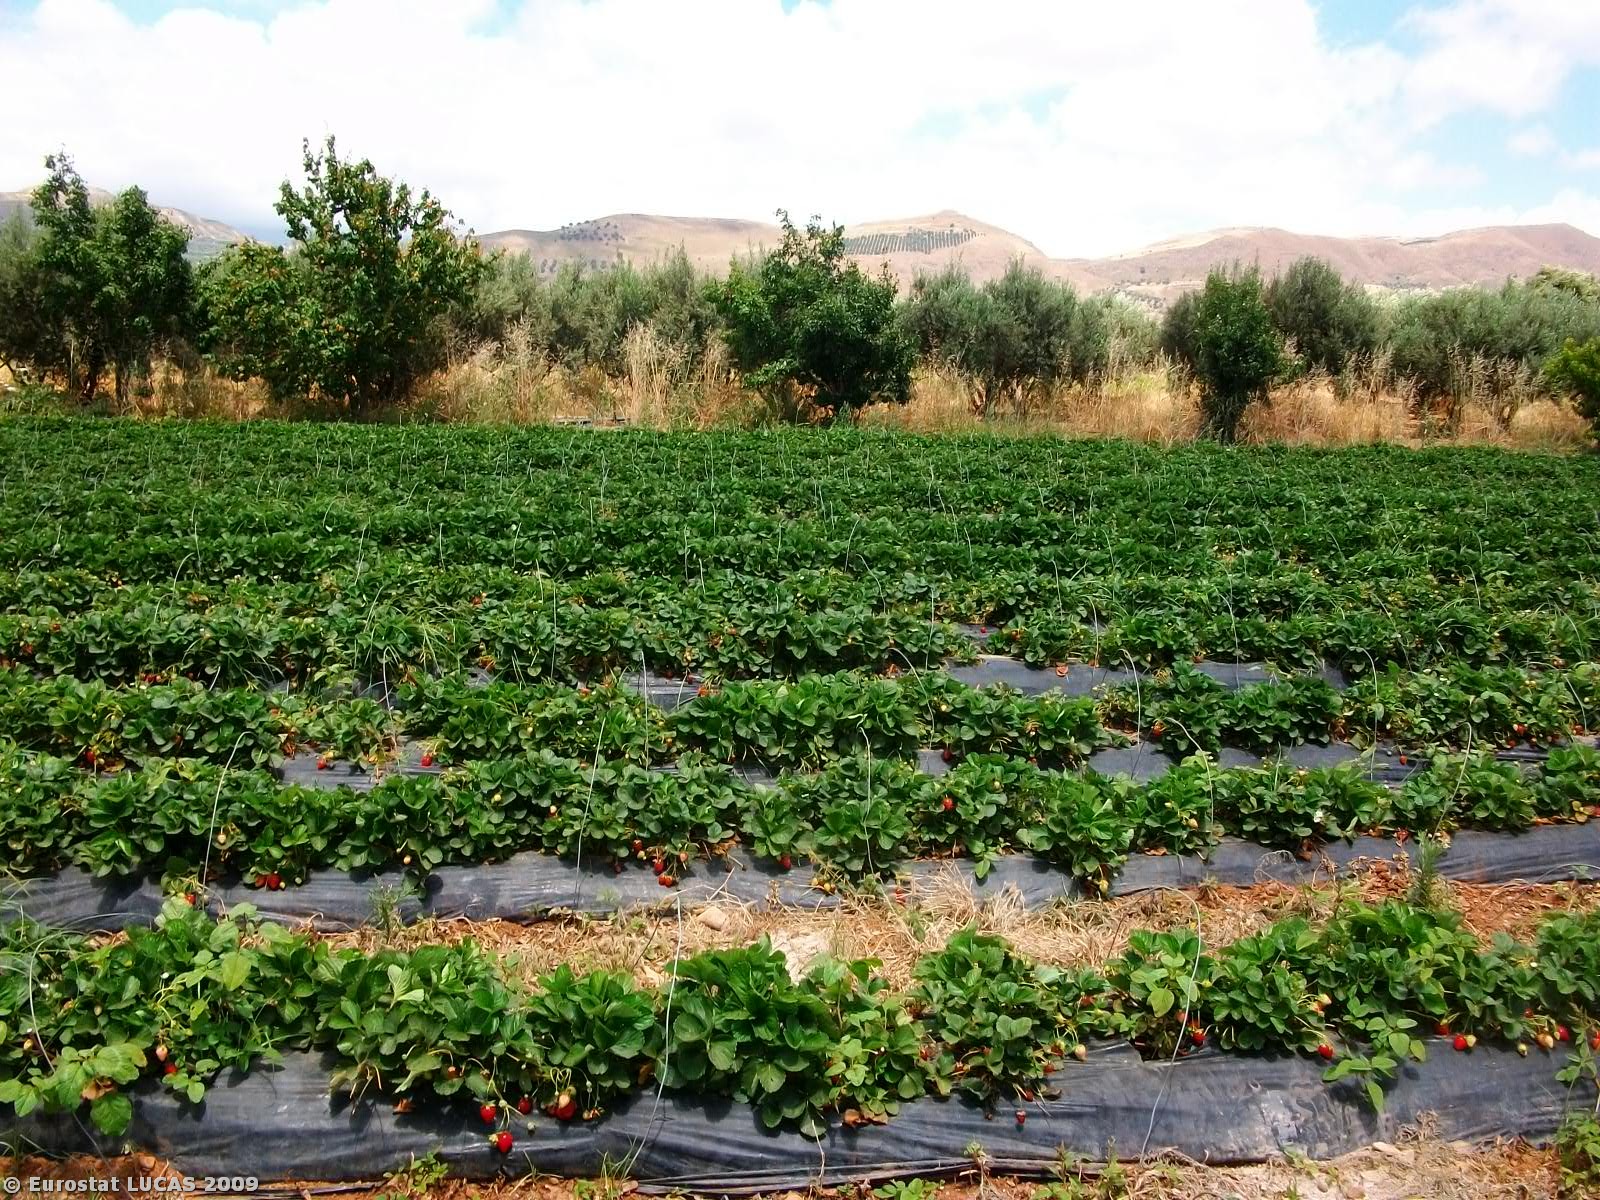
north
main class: Cropland
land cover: Strawberries
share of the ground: 50 - 75 %
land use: Agriculture (excluding fallow land and kitchen gardens)
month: June
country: GR
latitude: 35.0476
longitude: 24.9501
